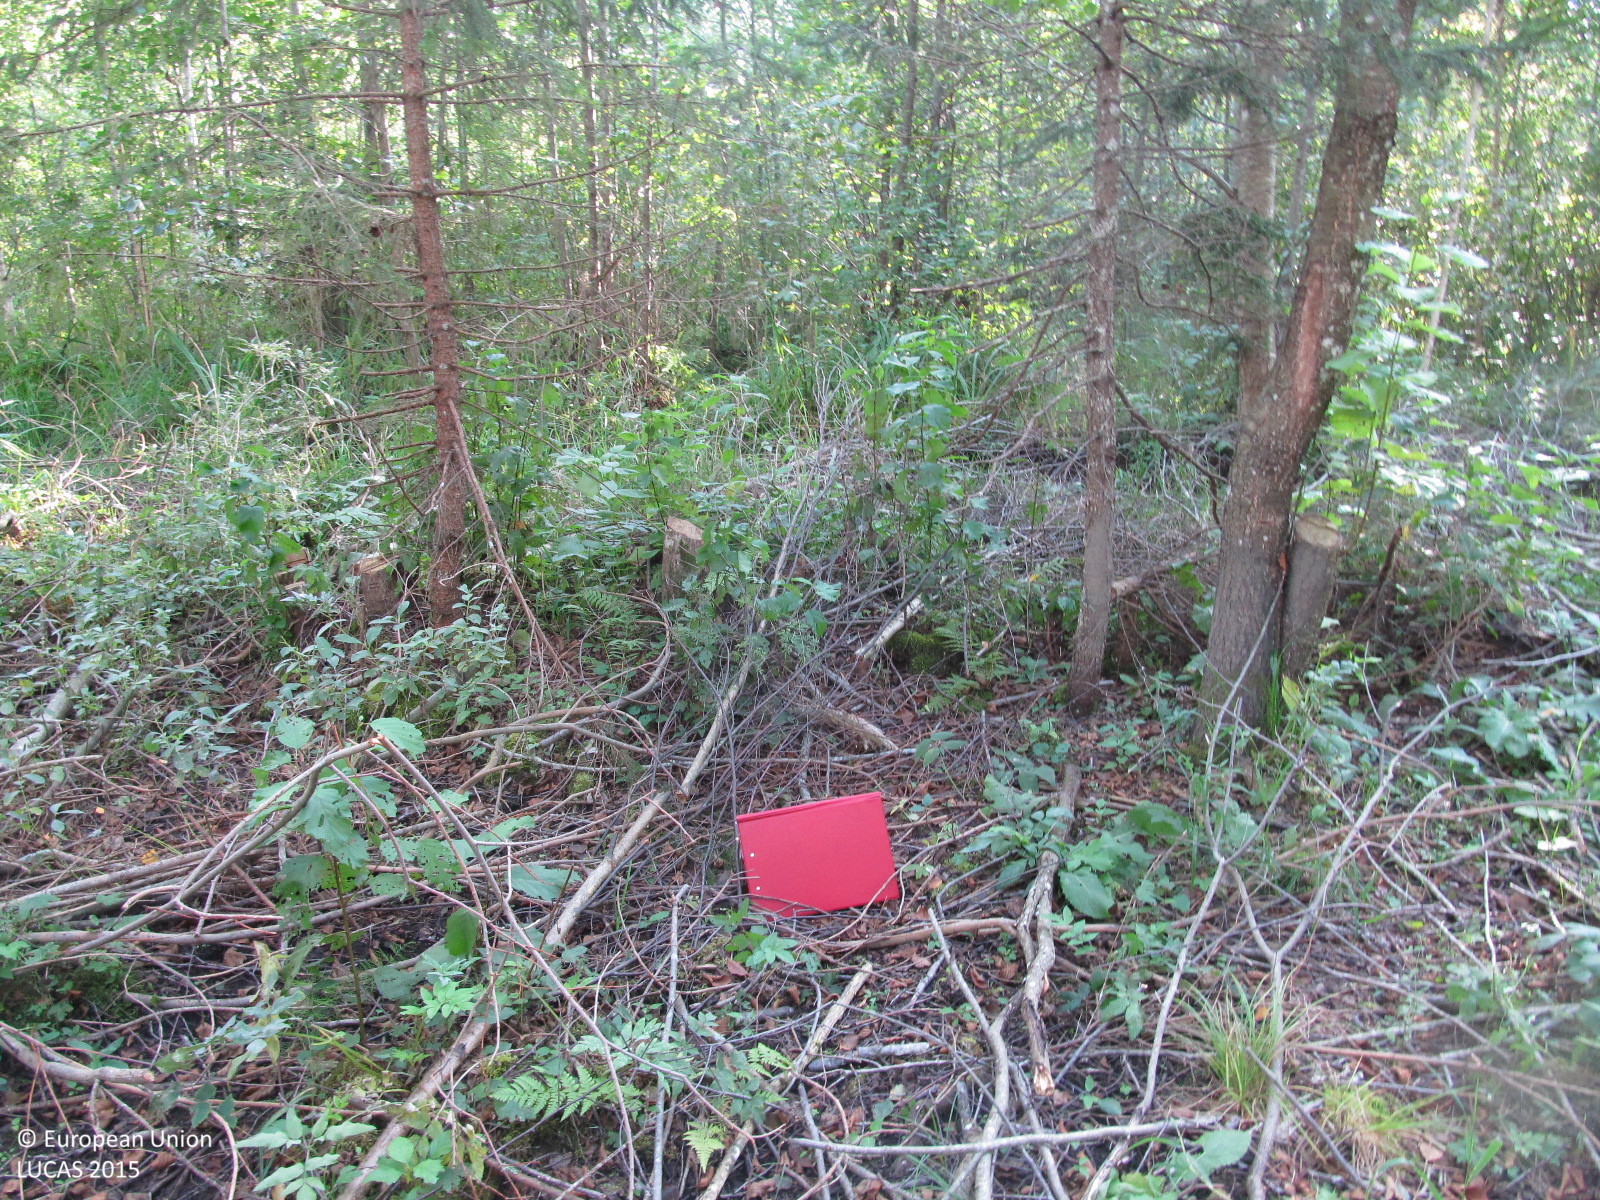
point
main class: Woodland
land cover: Broadleaved woodland
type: non-riverine alder, birch or aspen forest
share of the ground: 50 - 75 %
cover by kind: broadleaved forest trees 60 %, herbaceous plants 20 %, coniferous forest trees 10 %, lichens and mosses 5 %, unconsolidated bare surface 5 %
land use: Forestry
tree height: > 5 m
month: September
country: LT
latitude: 56.1221
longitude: 23.3771
